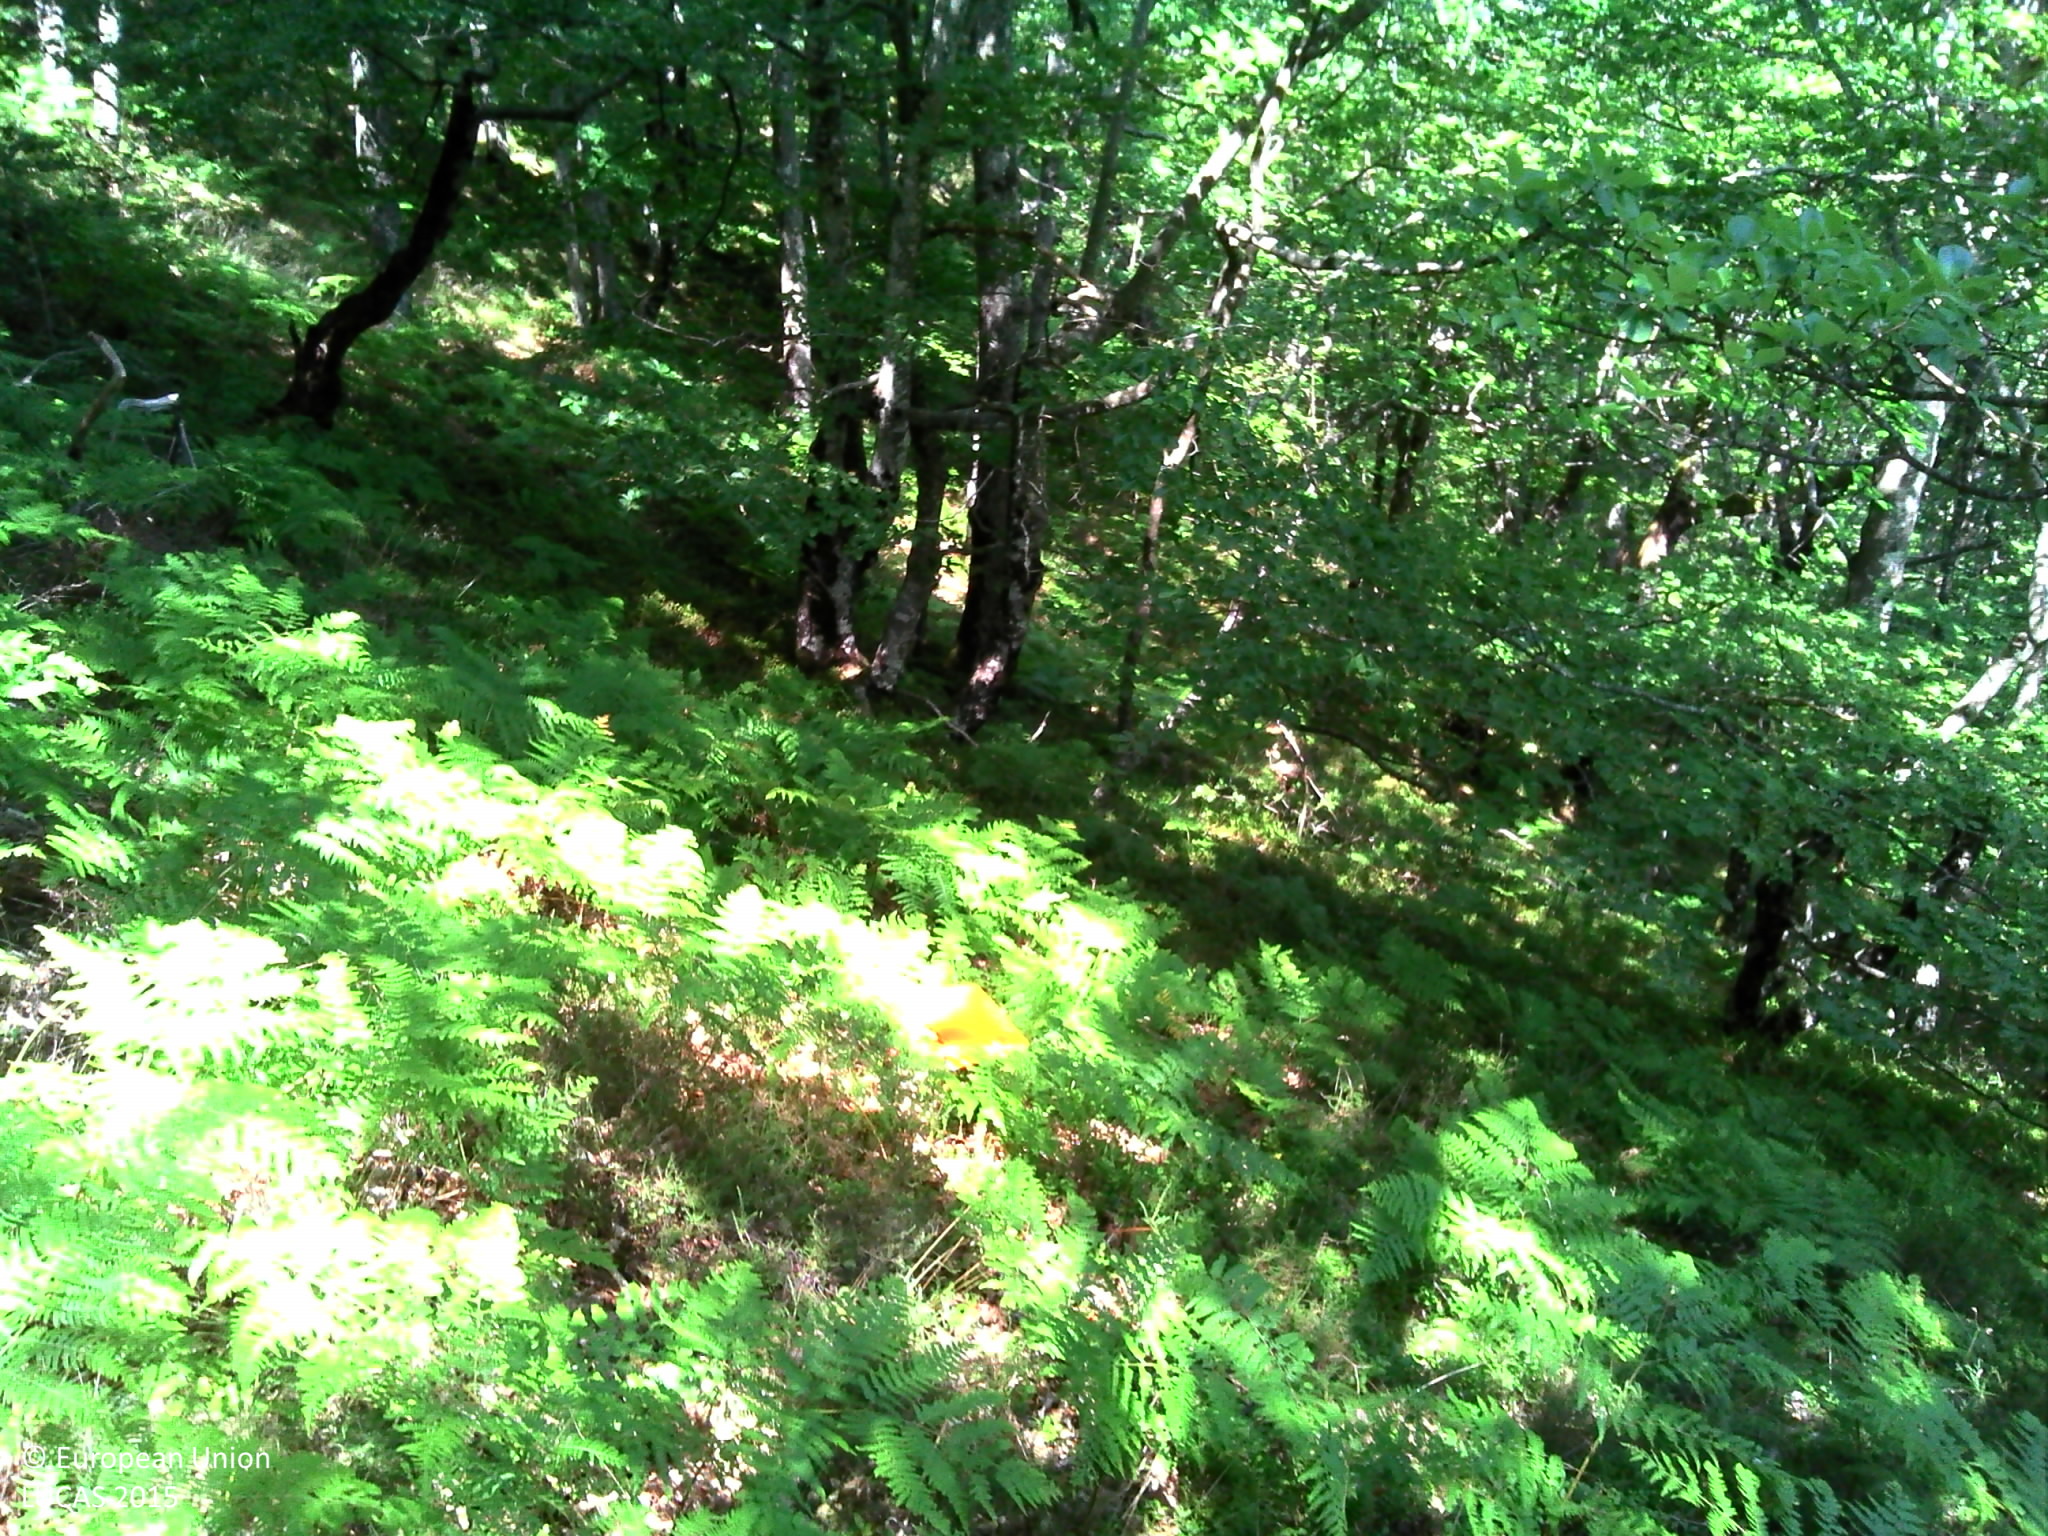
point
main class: Woodland
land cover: Broadleaved woodland
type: acidophilous oak and oak-birch forest
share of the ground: > 75 %
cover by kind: broadleaved forest trees 90 %, shrubs 5 %, herbaceous plants 5 %
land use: Semi-natural and natural areas not in use
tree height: > 5 m
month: July
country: FR
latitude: 44.5299
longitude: 2.9950
